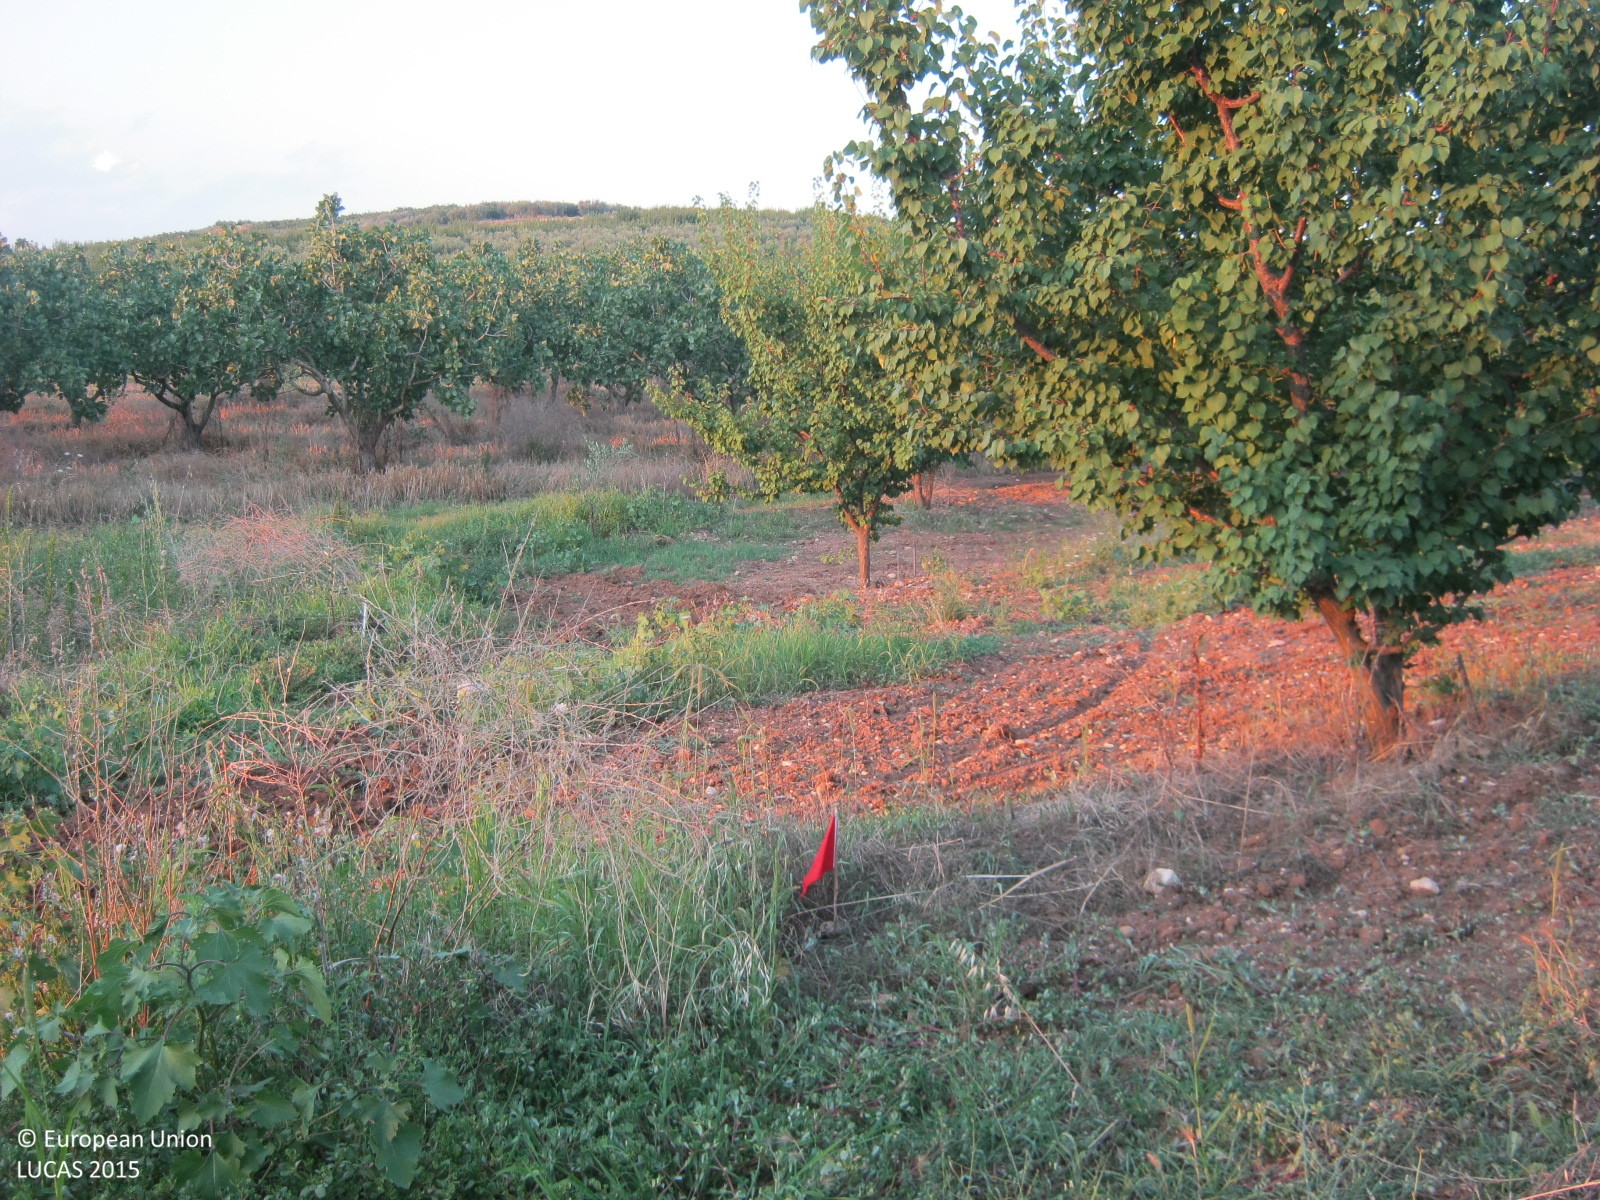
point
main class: Cropland
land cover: Other fruit trees and berries
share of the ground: 50 - 75 %
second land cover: Spontaneously vegetated surfaces
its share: 50 - 75 %
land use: Agriculture (excluding fallow land and kitchen gardens)
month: July
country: GR
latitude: 40.2895
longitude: 23.3114
